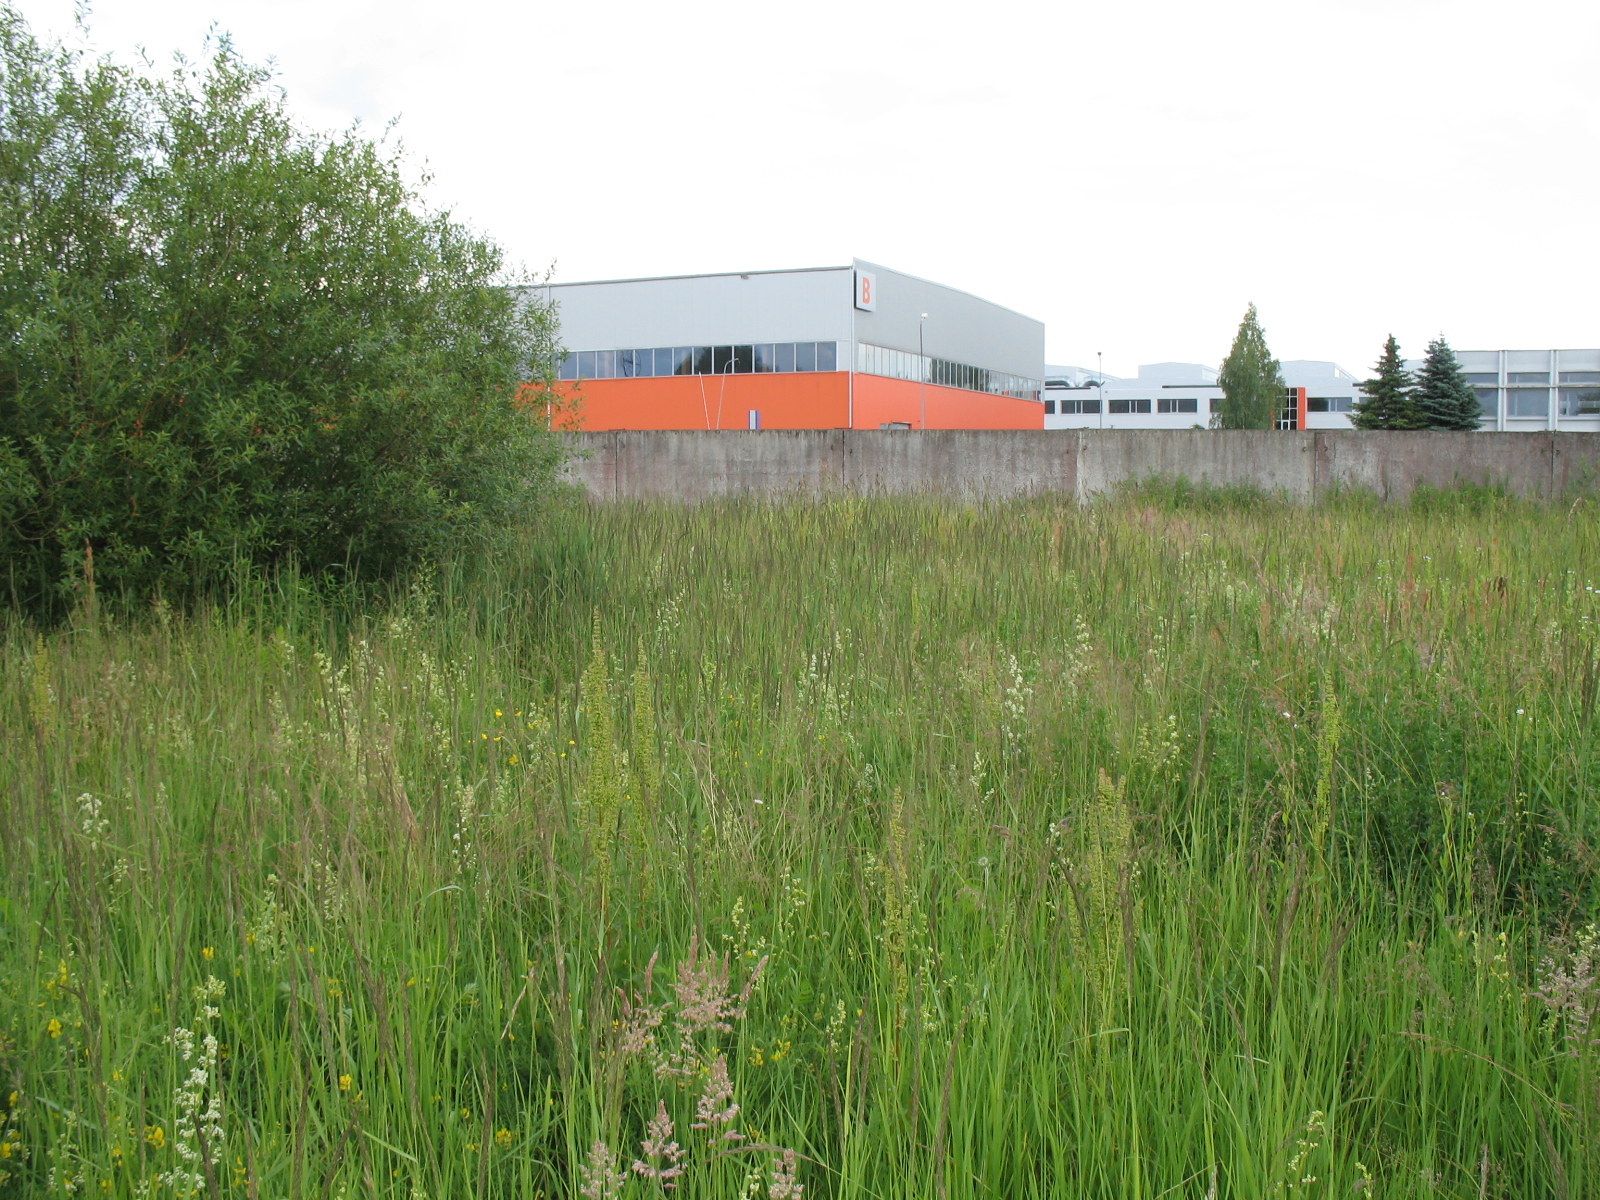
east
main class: Grassland
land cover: Grassland without tree/shrub cover
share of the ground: > 75 %
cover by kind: herbaceous plants 100 %
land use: Abandoned areas
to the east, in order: Grassland without tree/shrub cover; Fences; Grassland without tree/shrub cover; Paved roads, cycling and walking lanes; Grassland without tree/shrub cover; Artificial constructions in urban areas
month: June
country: LV
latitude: 56.6650
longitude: 23.7690
